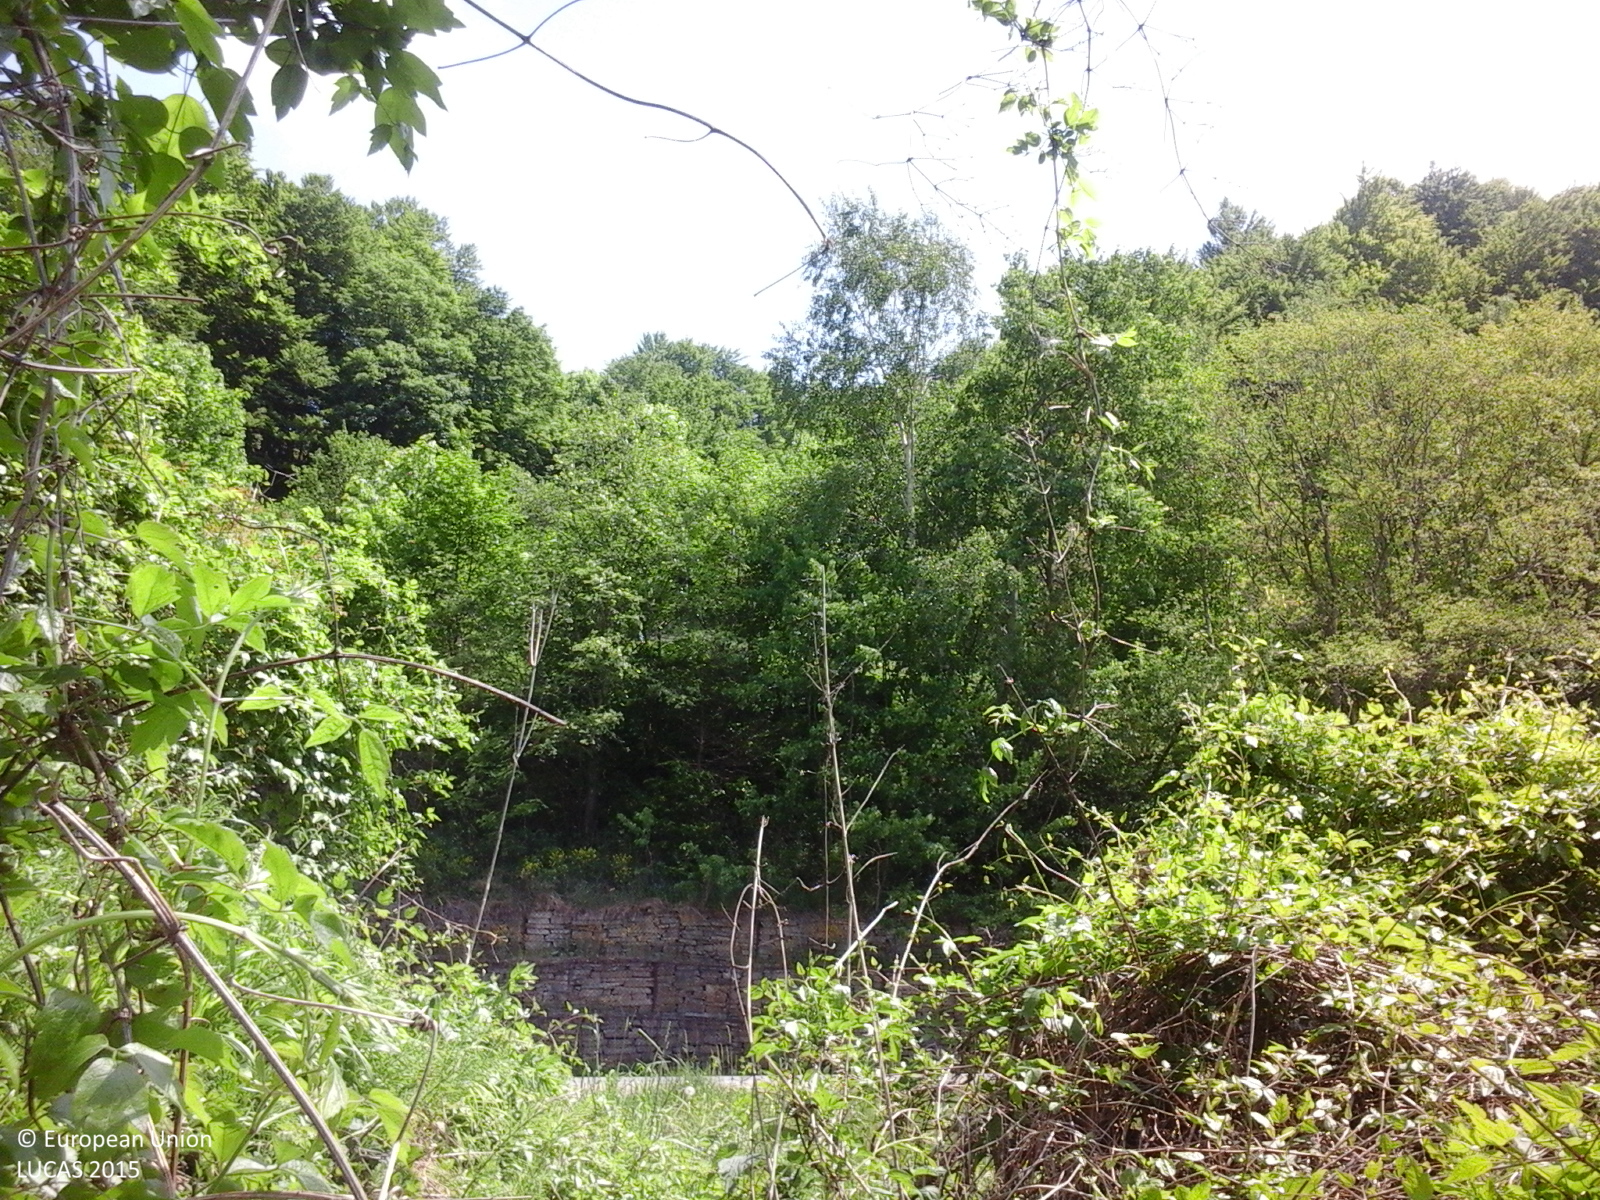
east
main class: Woodland
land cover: Broadleaved woodland
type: non-riverine alder, birch or aspen forest
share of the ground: > 75 %
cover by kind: broadleaved forest trees 75 %, shrubs 15 %, herbaceous plants 10 %
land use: Semi-natural and natural areas not in use
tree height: > 5 m
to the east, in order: Broadleaved woodland; Dry stone walls; Grassland without tree/shrub cover; Paved roads, cycling and walking lanes; Ditches and canals; Dry stone walls; Groves; Spontaneously vegetated surfaces; Grassland with sparse tree/shrub cover; Broadleaved woodland
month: May
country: RO
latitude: 45.5475
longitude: 26.1926
